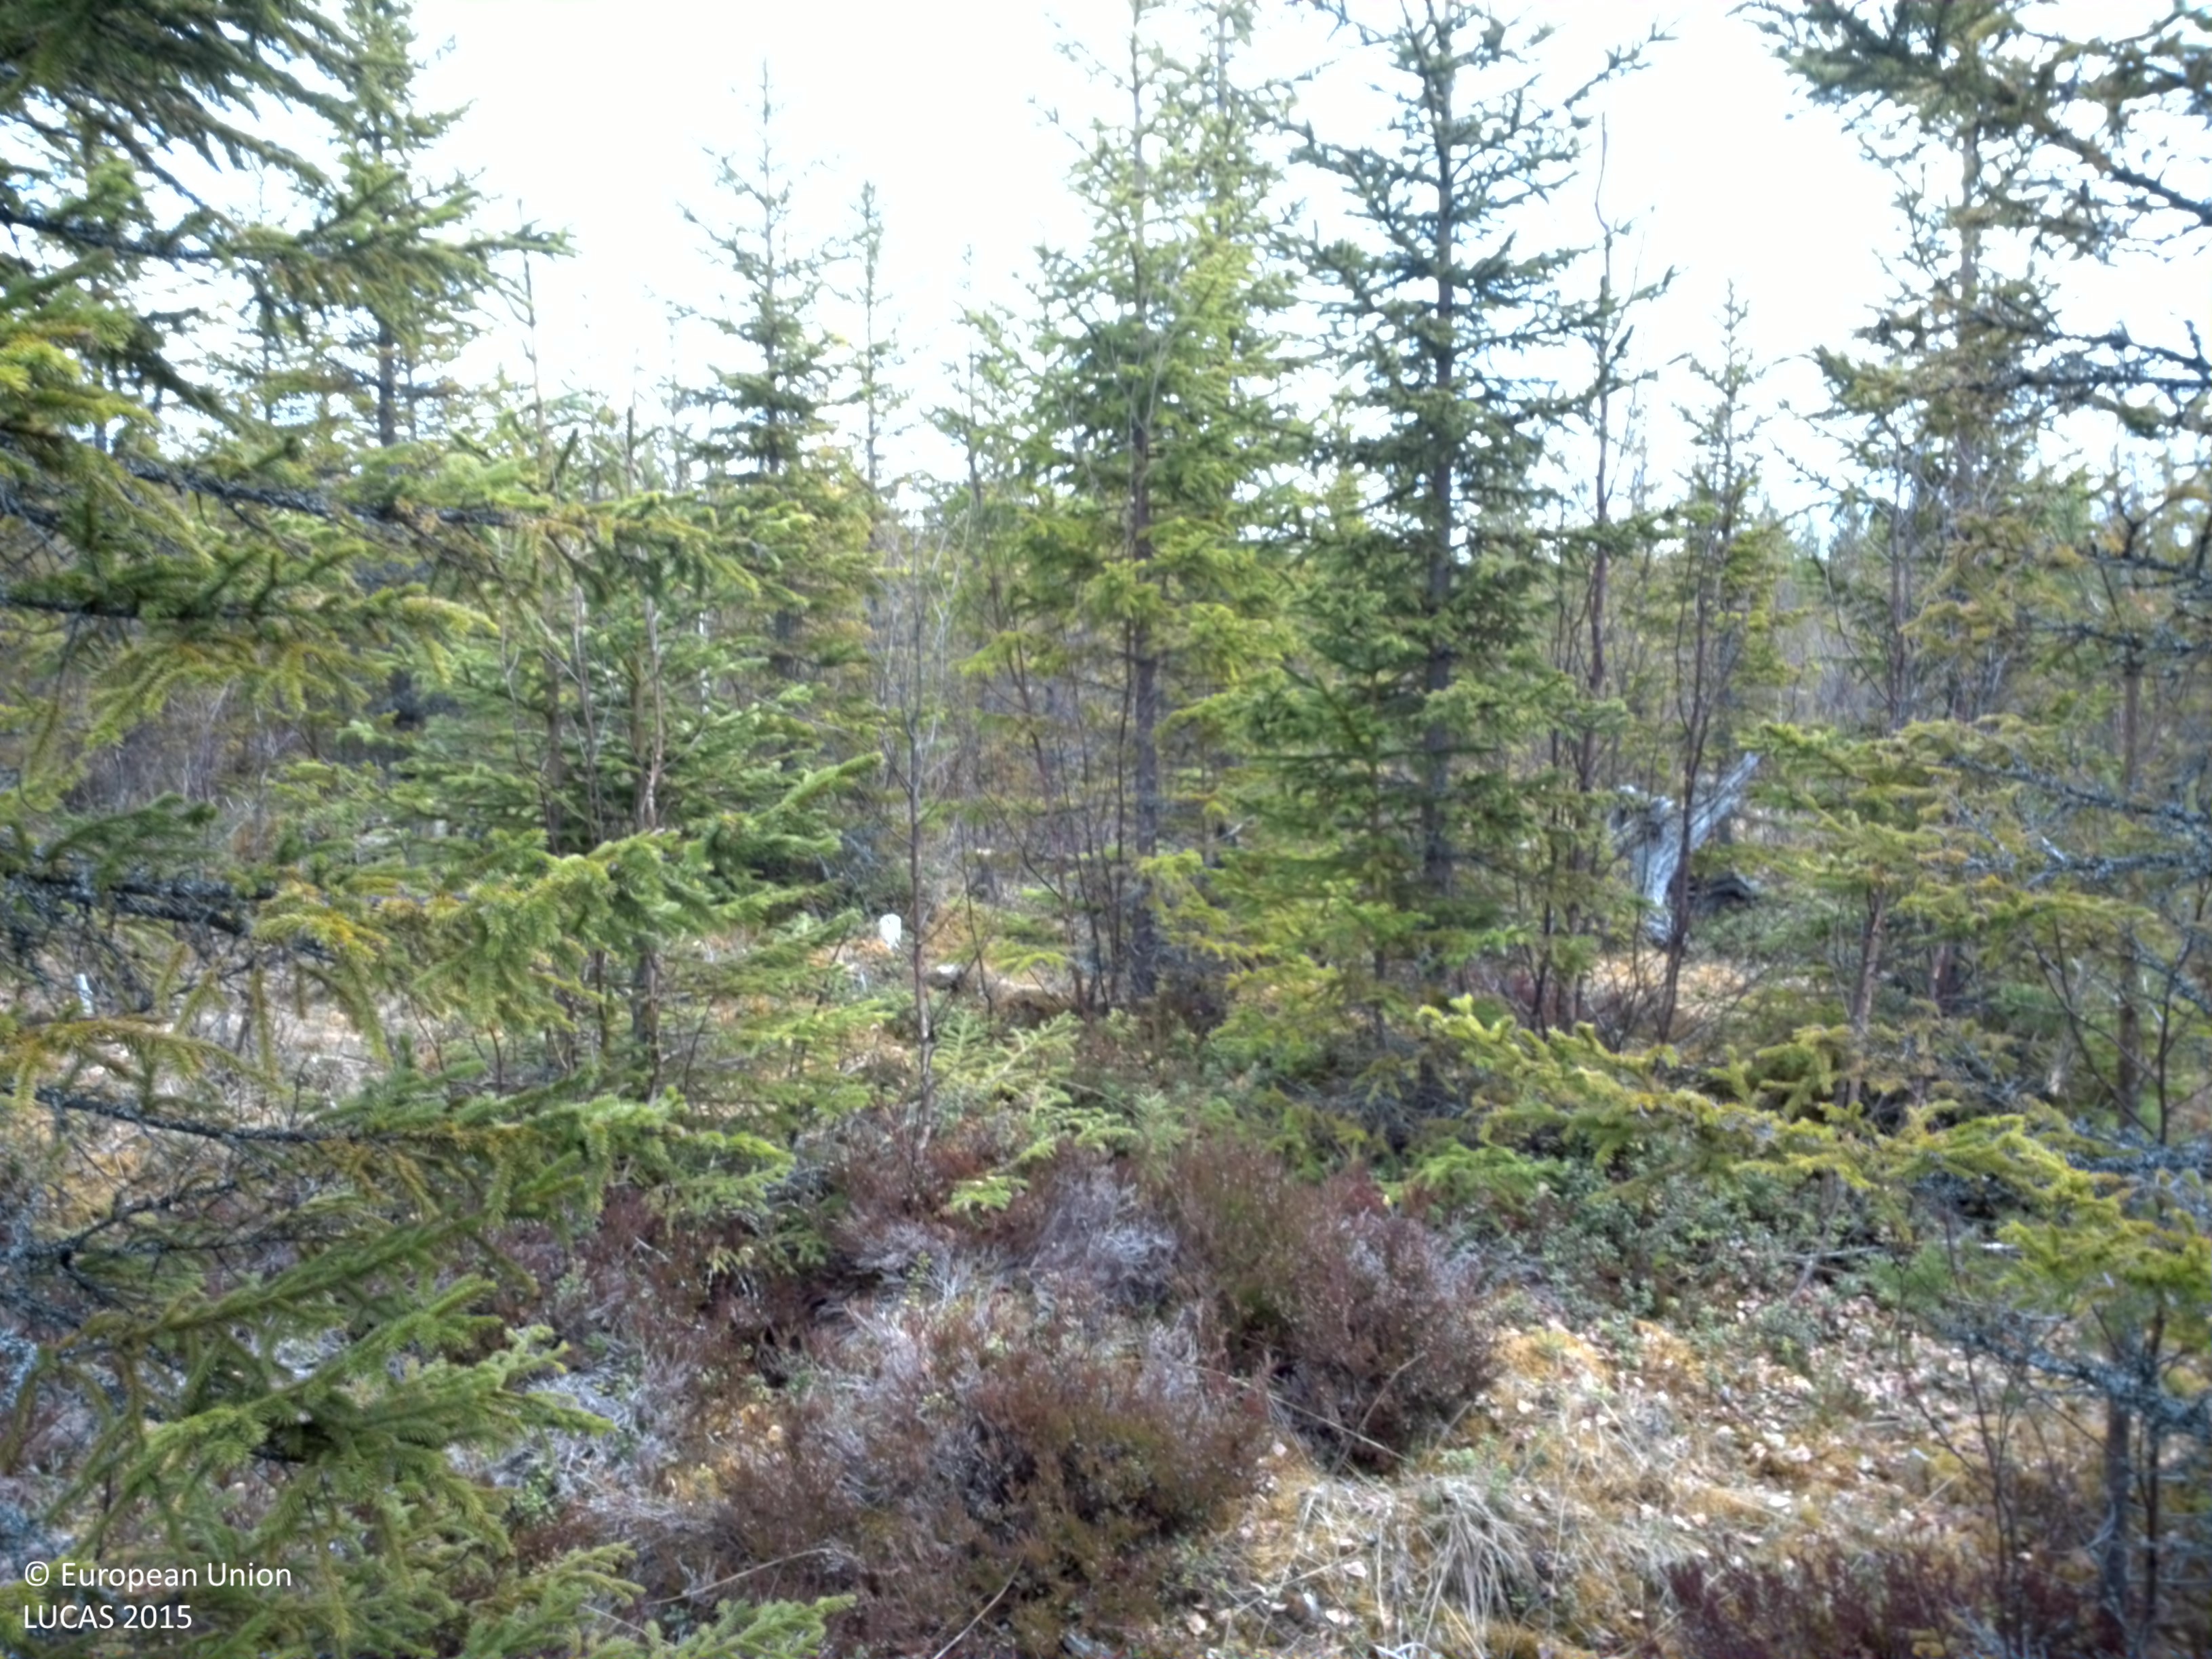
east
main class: Woodland
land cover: Spruce dominated coniferous woodland
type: boreal forest
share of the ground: > 75 %
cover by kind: coniferous forest trees 80 %, shrubs 20 %
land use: Forestry
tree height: > 5 m
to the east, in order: Spruce dominated coniferous woodland; Ditches and canals; Spruce dominated coniferous woodland; Ditches and canals
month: May
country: SE
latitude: 62.6190
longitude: 14.4446
